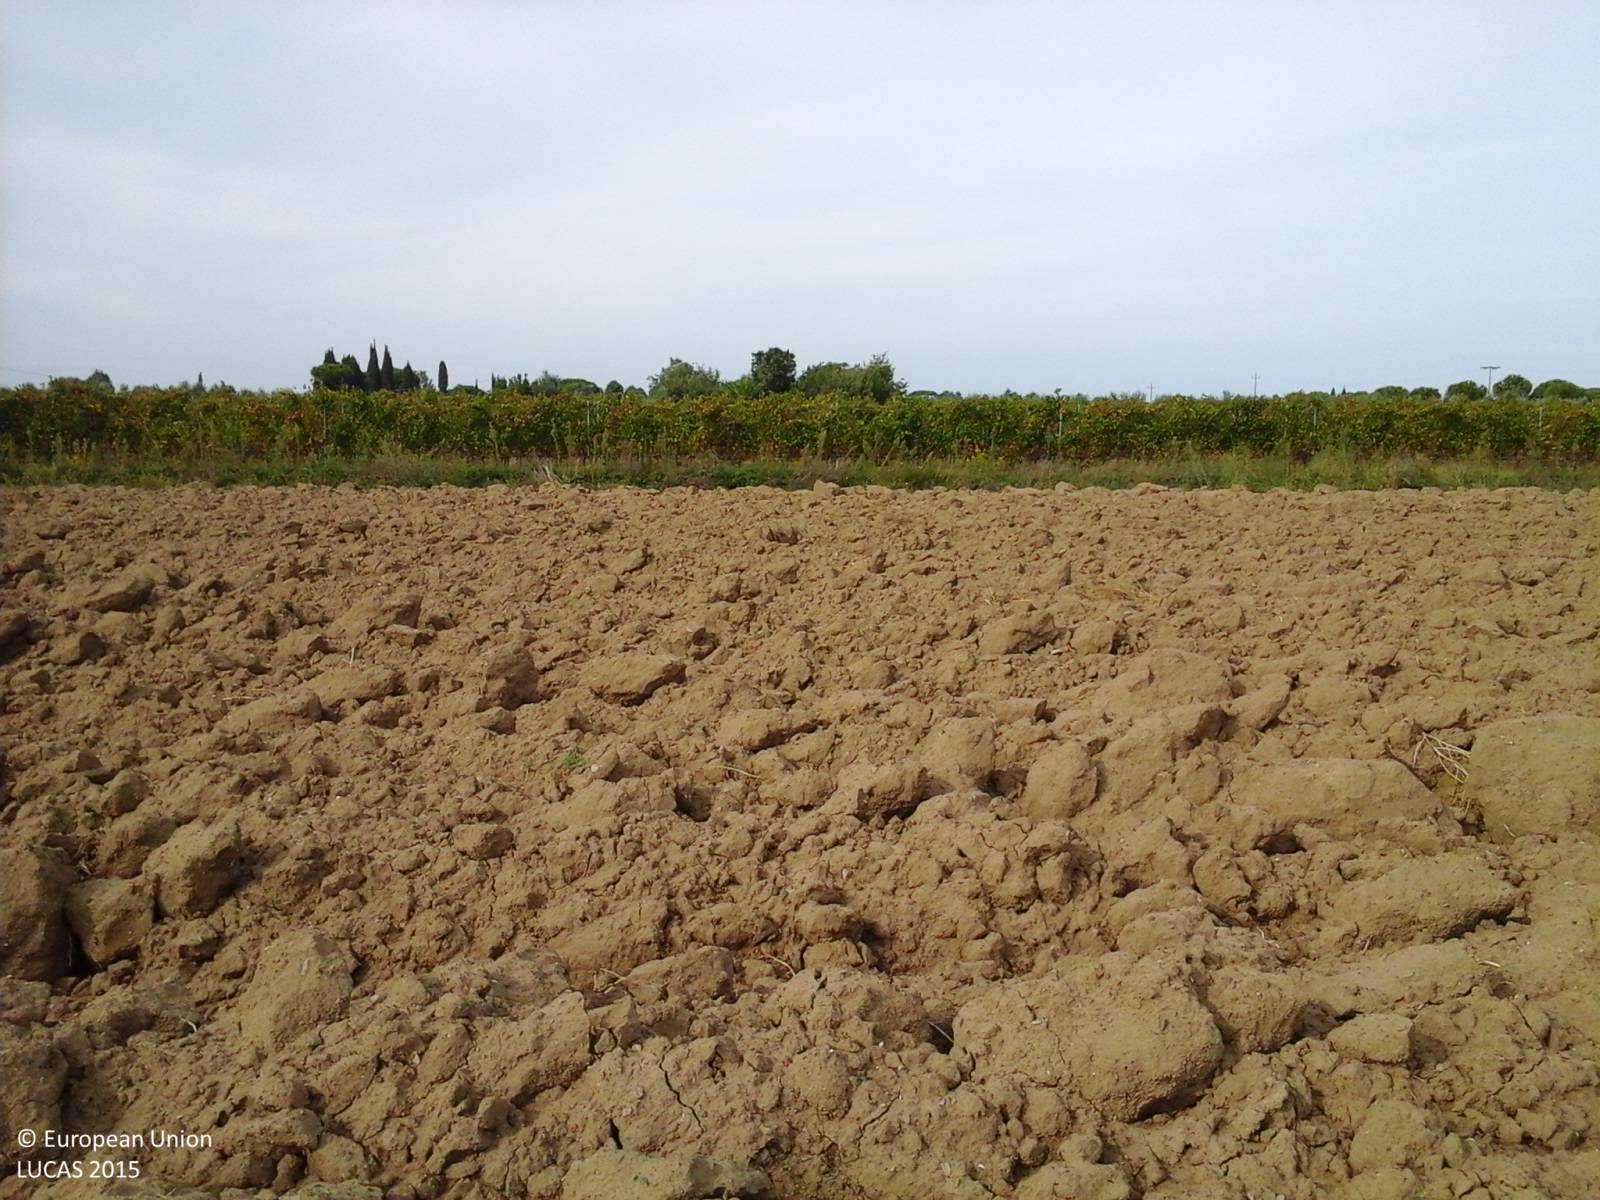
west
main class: Cropland
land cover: Tomatoes
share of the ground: < 10 %
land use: Agriculture (excluding fallow land and kitchen gardens)
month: October
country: IT
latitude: 43.1941
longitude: 10.5766
